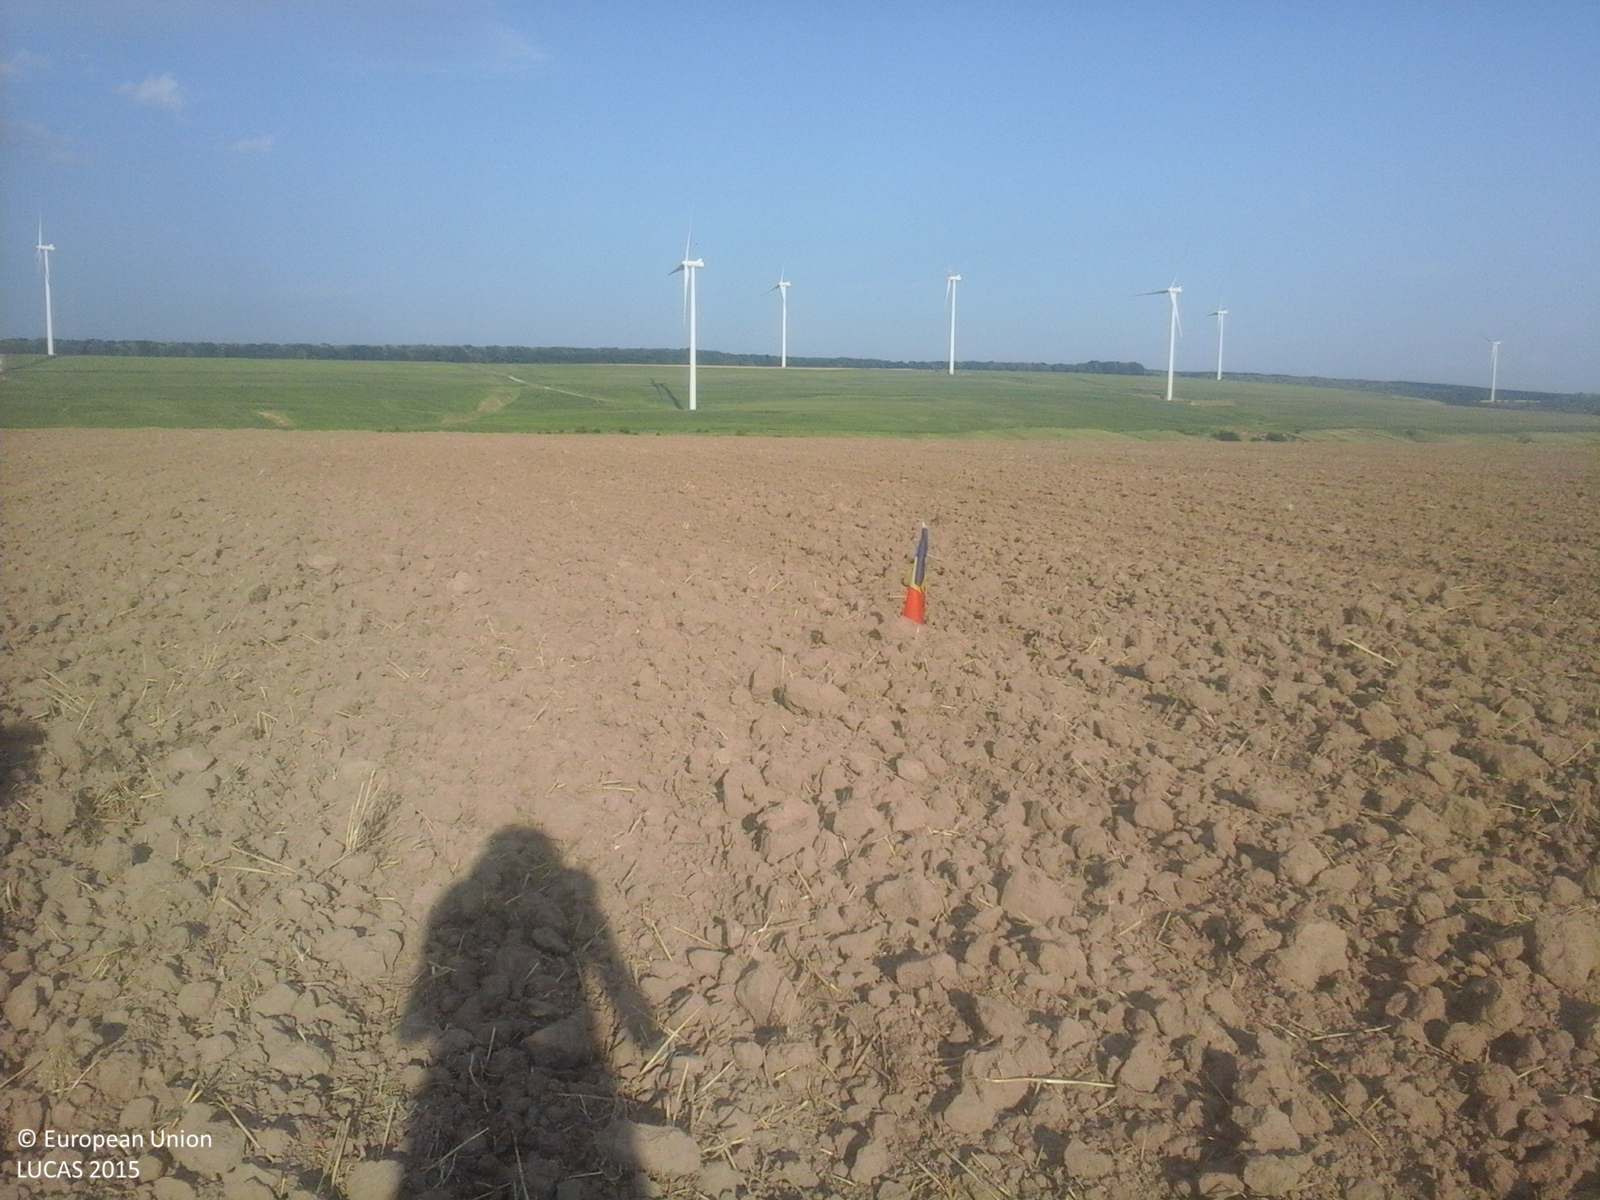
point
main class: Cropland
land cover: Durum wheat
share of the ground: < 10 %
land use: Agriculture (excluding fallow land and kitchen gardens)
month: July
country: RO
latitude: 46.5400
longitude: 27.8967
